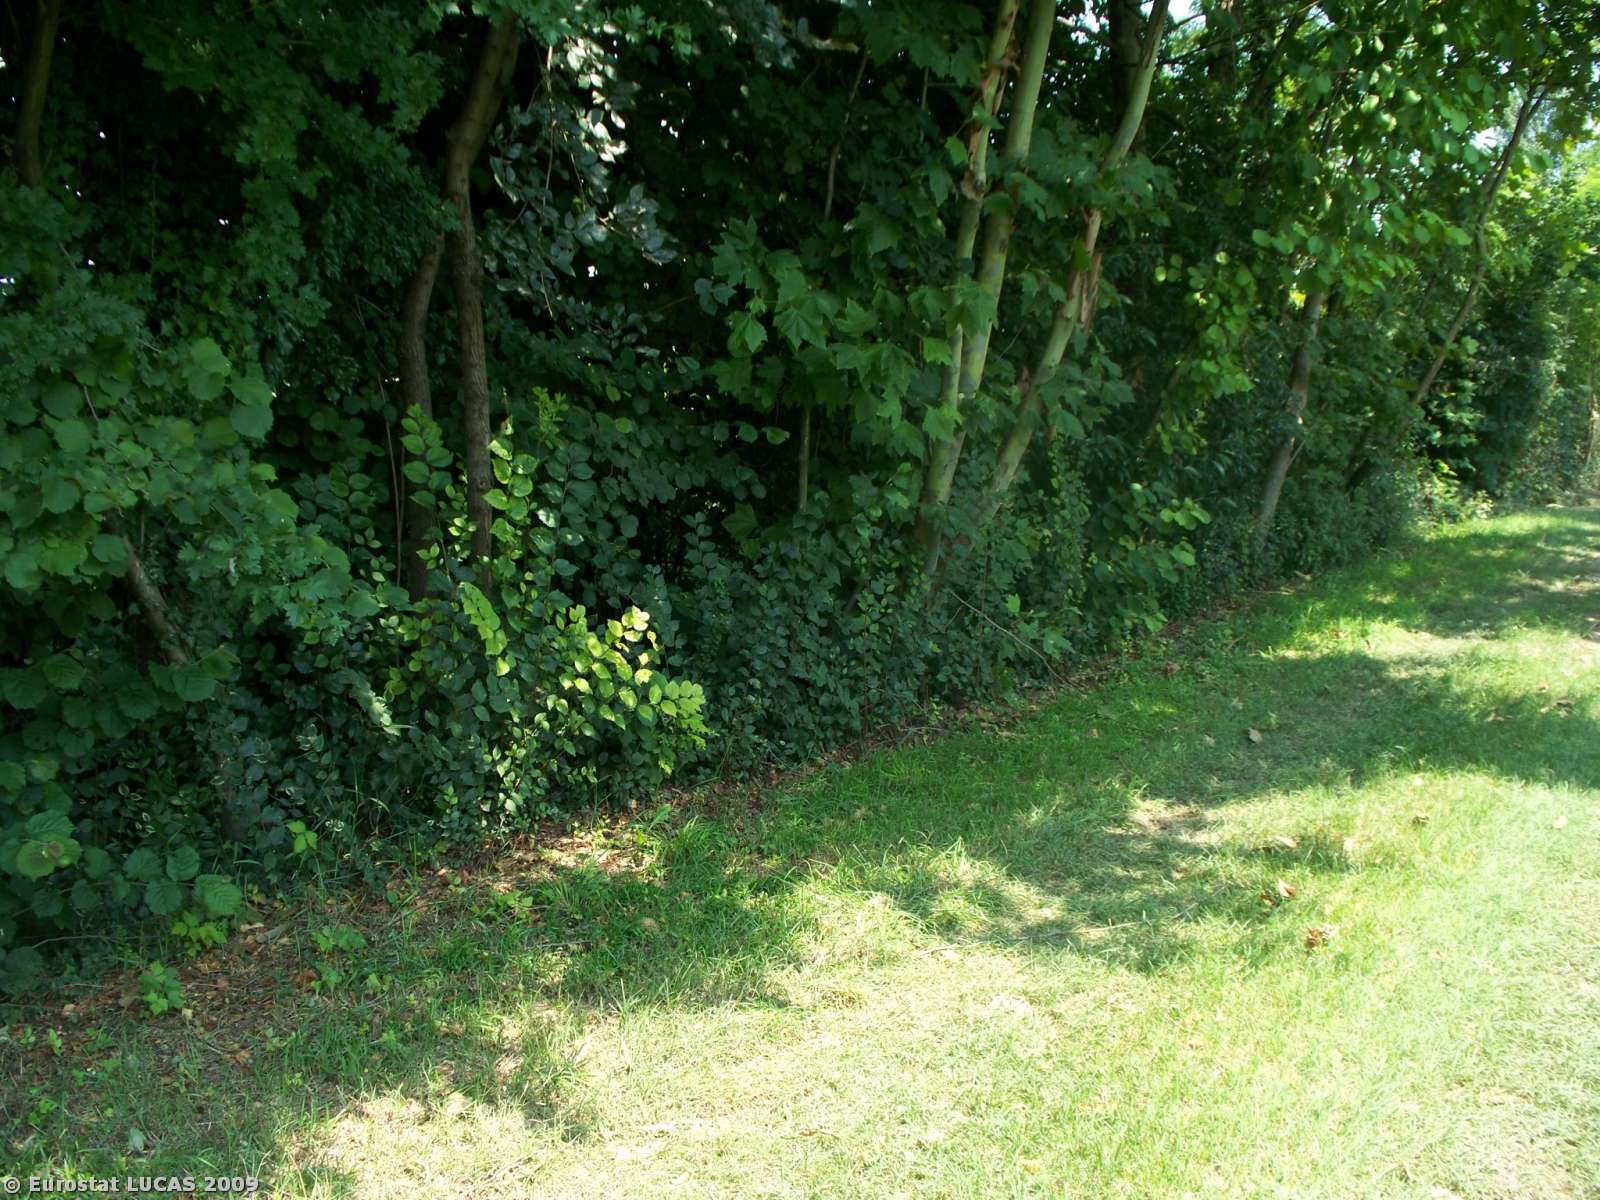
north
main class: Cropland
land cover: Maize
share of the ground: > 75 %
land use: Agriculture (excluding fallow land and kitchen gardens)
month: July
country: IT
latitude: 45.8910
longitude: 12.4324
